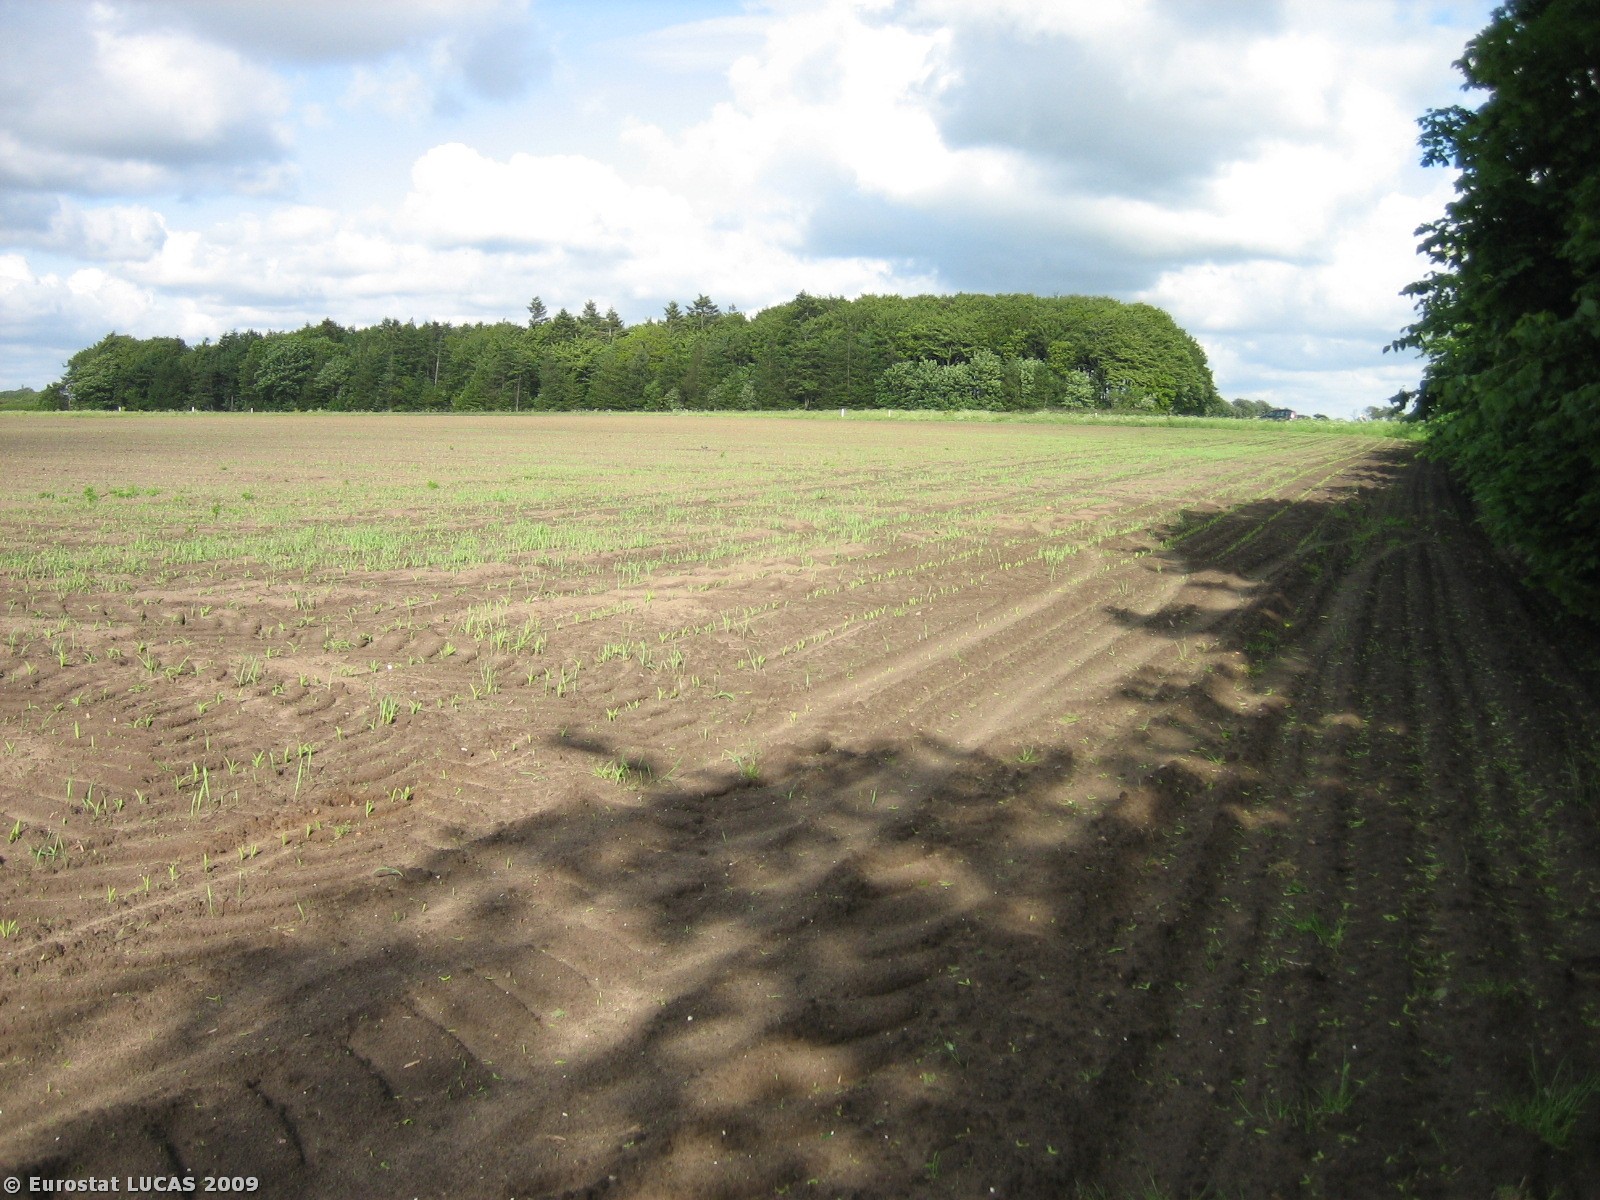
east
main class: Cropland
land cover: Maize
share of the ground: < 10 %
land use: Agriculture (excluding fallow land and kitchen gardens)
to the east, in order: Maize; Grassland without tree/shrub cover; Paved roads, cycling and walking lanes; Grassland without tree/shrub cover; Tracks; Grassland without tree/shrub cover; Broadleaved woodland
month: May
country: DK
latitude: 56.0934
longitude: 8.9243
